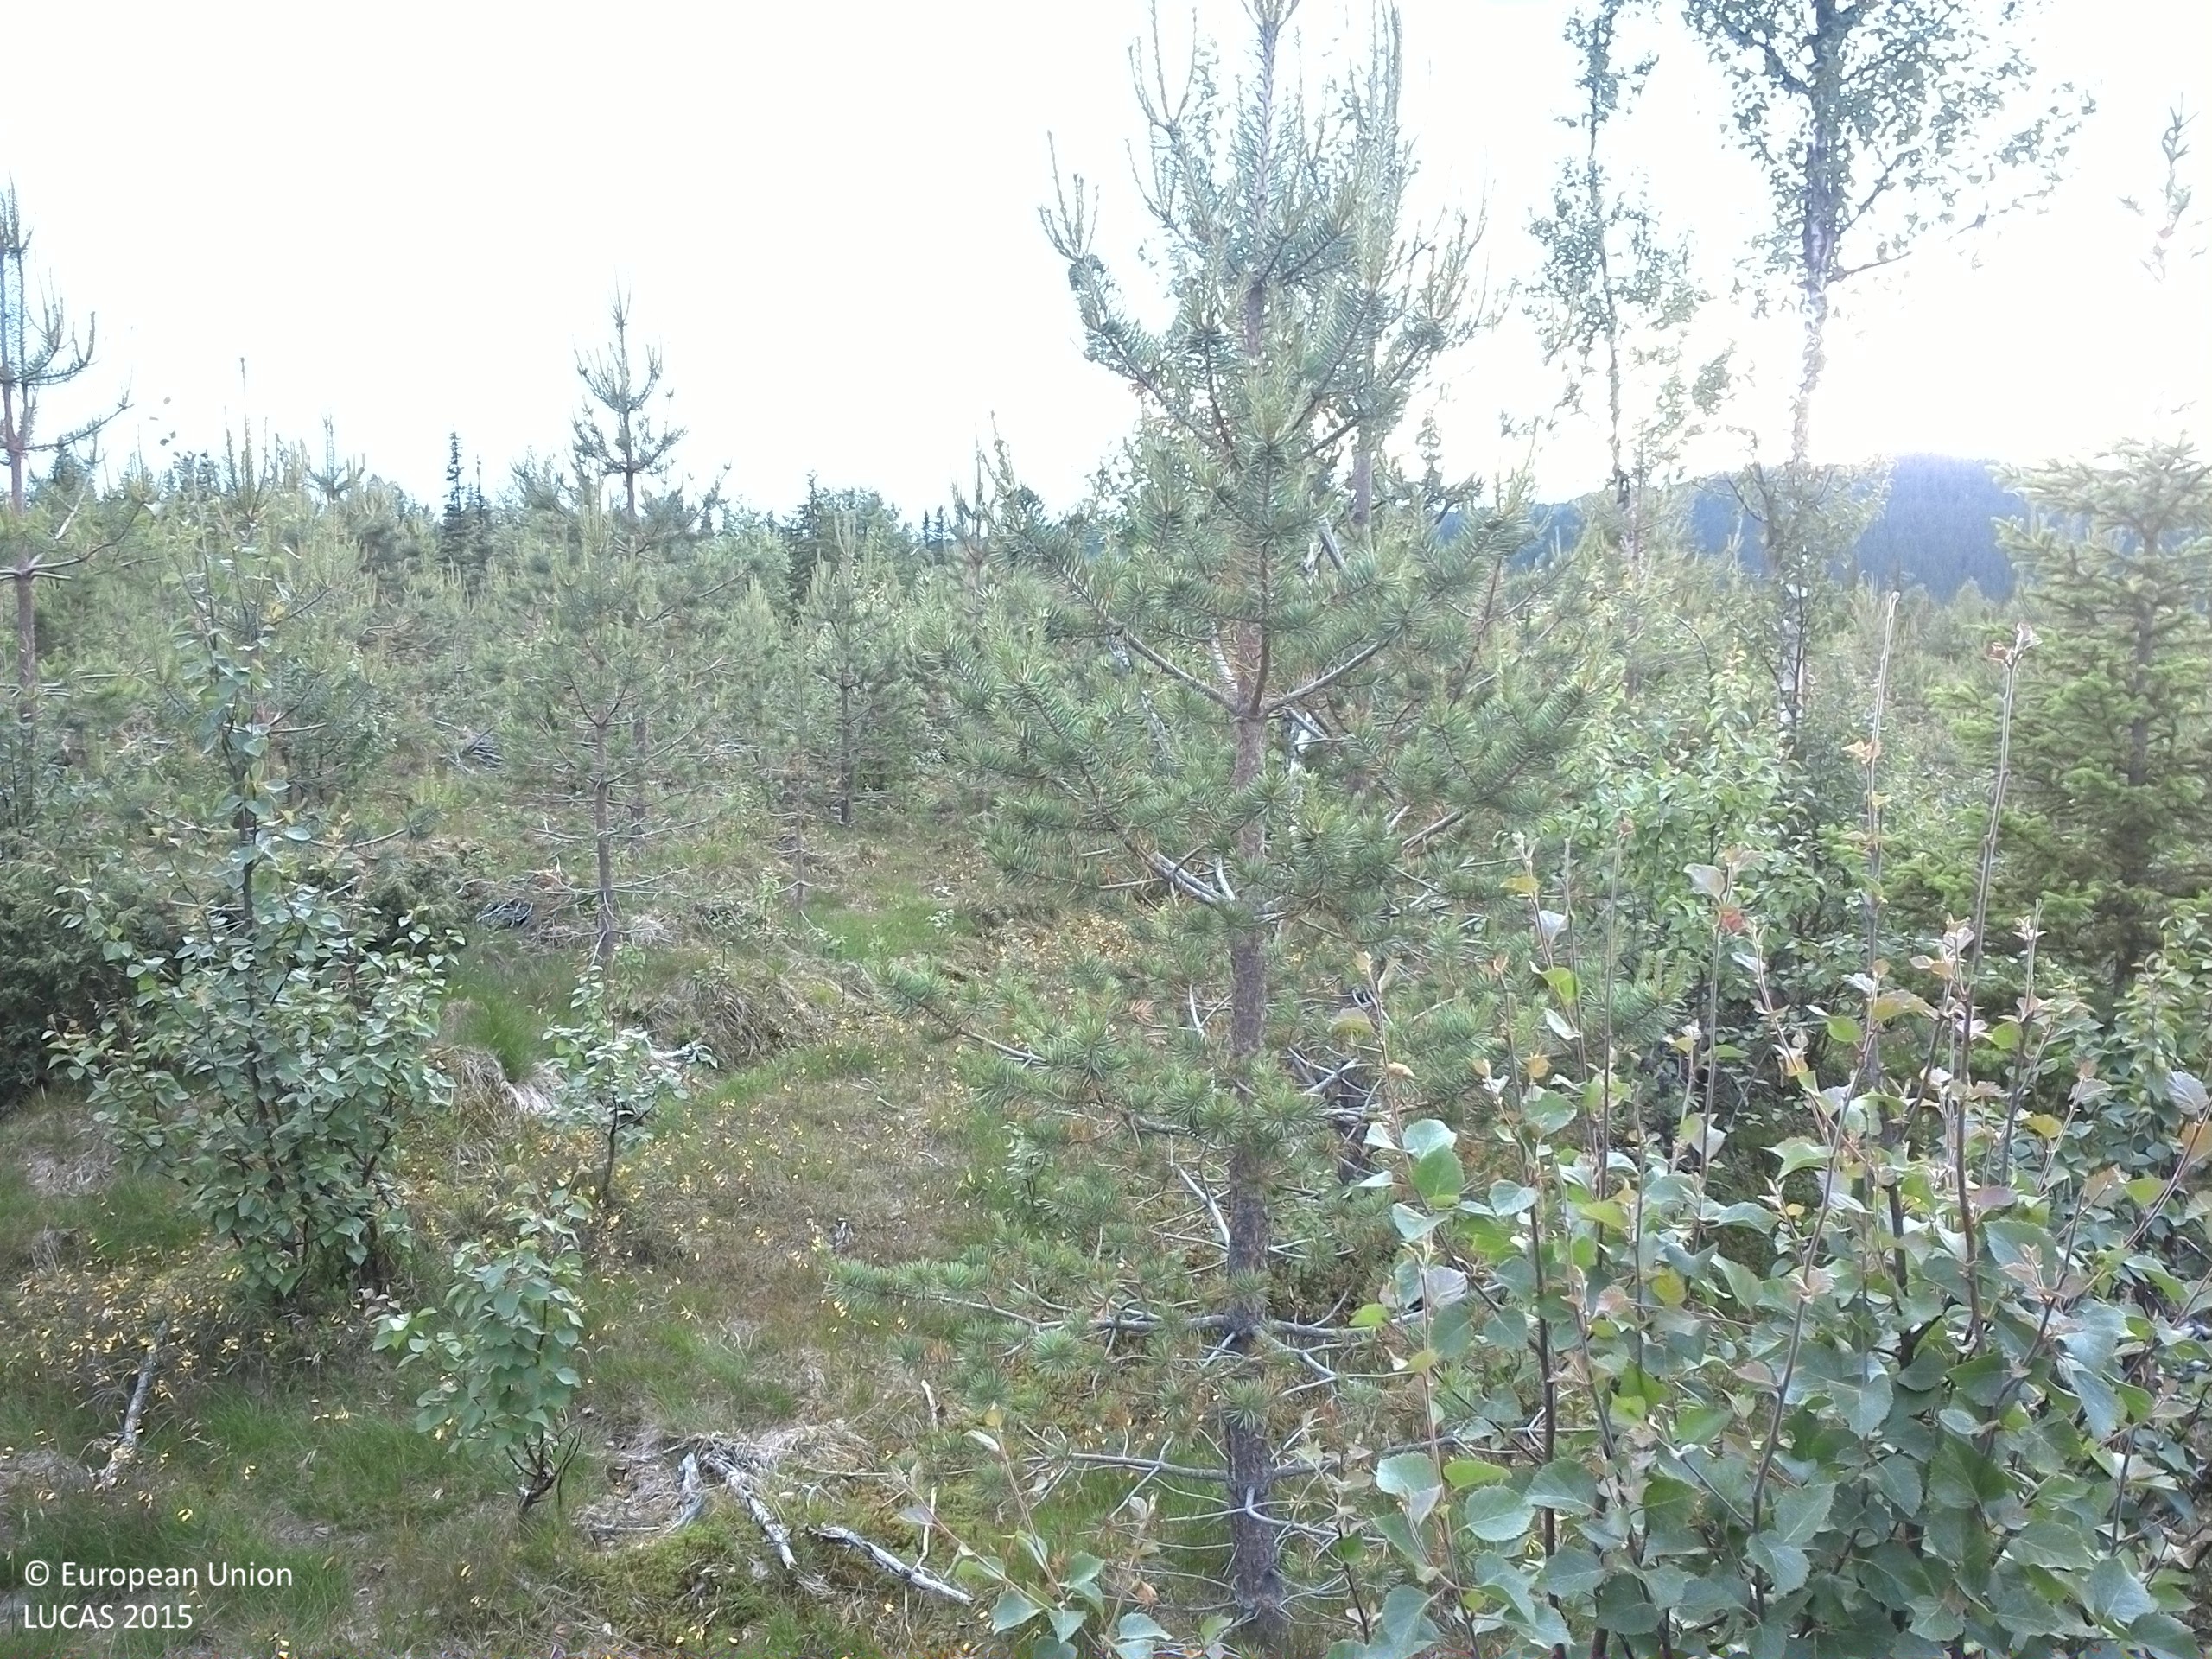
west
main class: Woodland
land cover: Pine dominated coniferous woodland
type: boreal forest
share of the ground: 10 - 25 %
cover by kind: herbaceous plants 60 %, coniferous forest trees 20 %, lichens and mosses 15 %, broadleaved forest trees 5 %
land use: Forestry
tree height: < 5 m
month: July
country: SE
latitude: 64.6765
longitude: 15.6890
